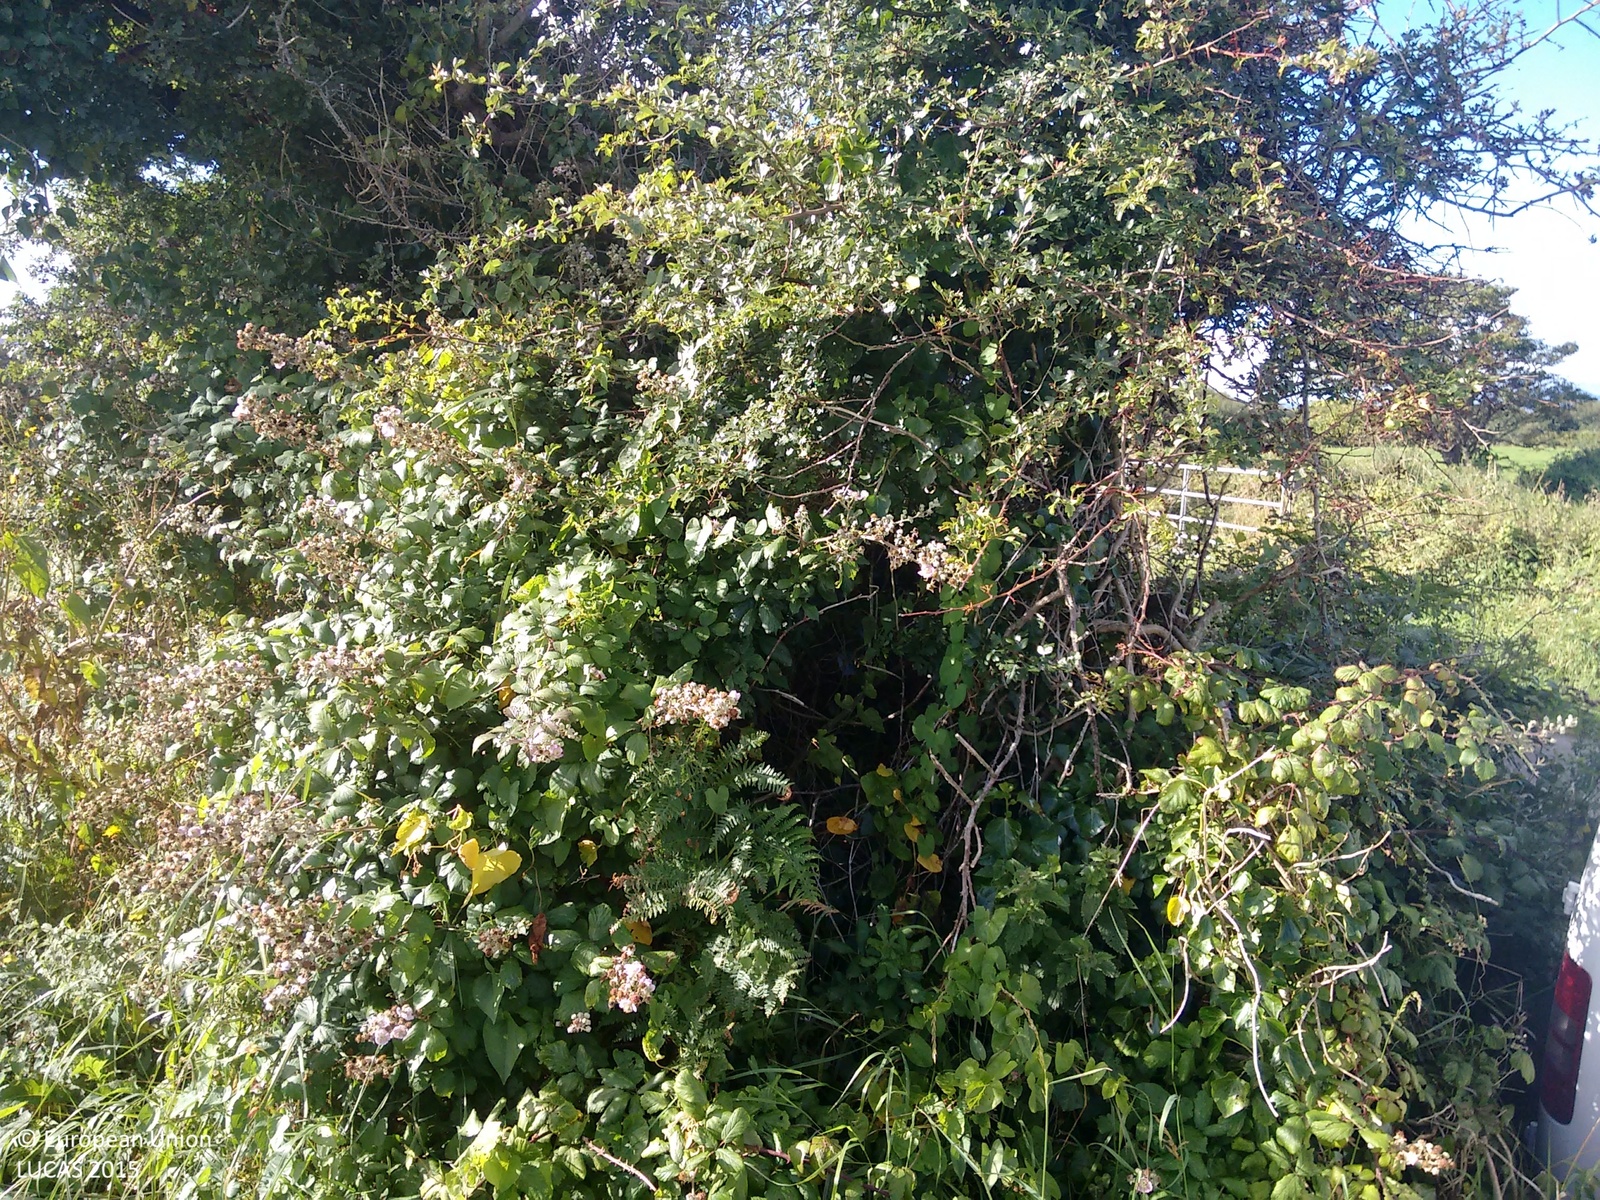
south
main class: Cropland
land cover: Barley
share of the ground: > 75 %
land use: Agriculture (excluding fallow land and kitchen gardens)
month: September
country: IE
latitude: 52.3165
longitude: -9.8003
